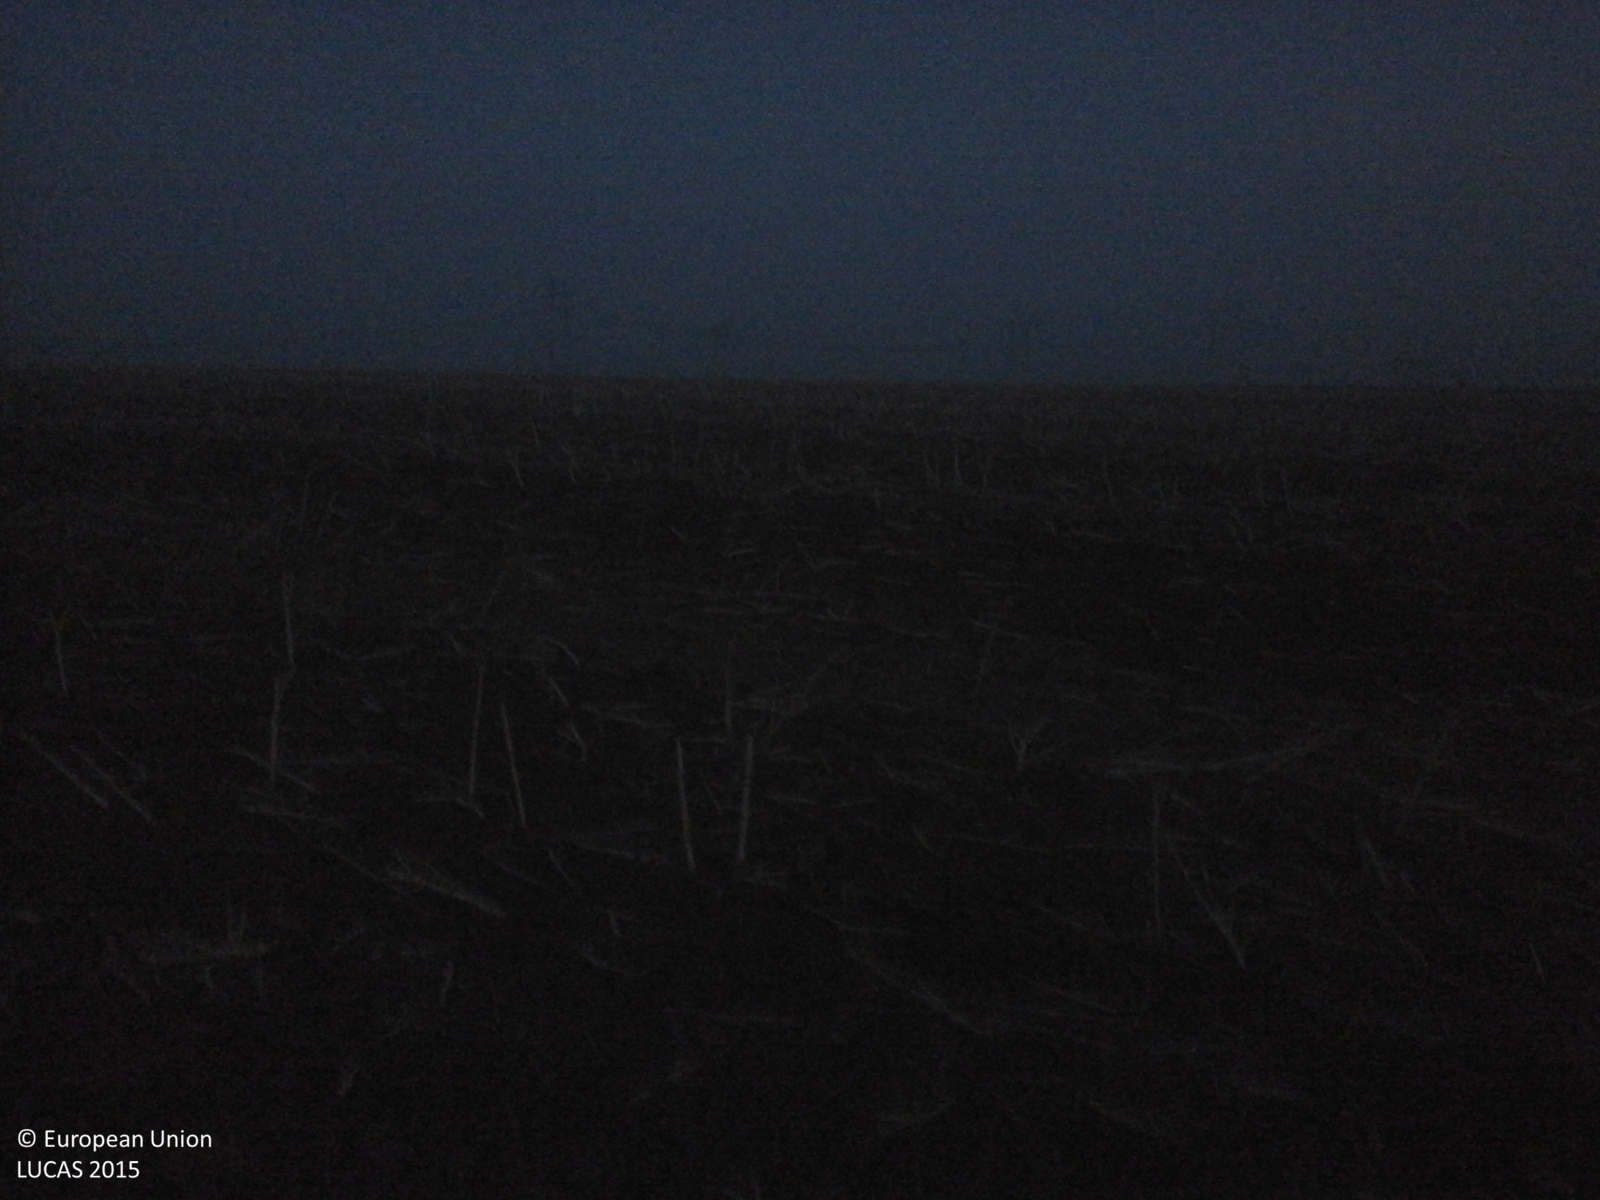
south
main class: Cropland
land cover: Rape and turnip rape
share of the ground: 25 - 50 %
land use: Agriculture (excluding fallow land and kitchen gardens)
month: August
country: RO
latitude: 44.1496
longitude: 28.0718
